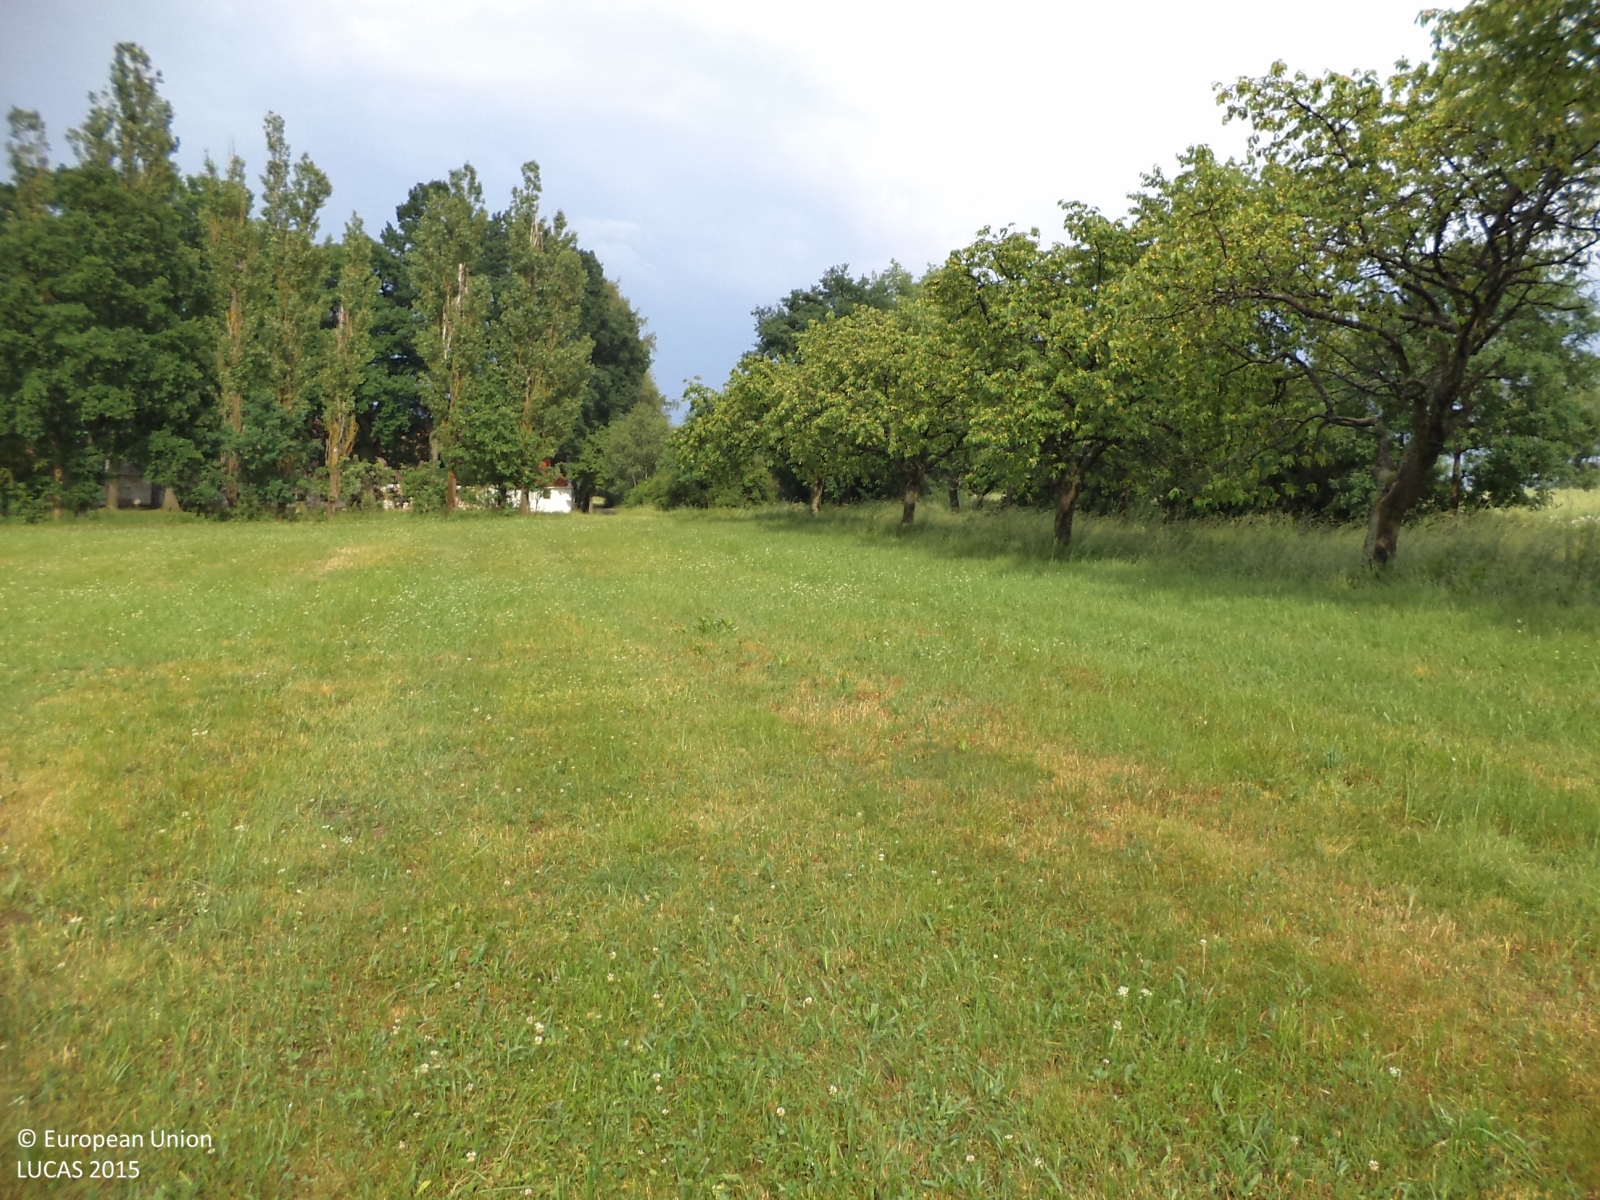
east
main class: Grassland
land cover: Grassland without tree/shrub cover
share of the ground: > 75 %
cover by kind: herbaceous plants 100 %
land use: Agriculture (excluding fallow land and kitchen gardens)
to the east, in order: Grassland without tree/shrub cover; Lines of trees; Paved roads, cycling and walking lanes; Shrubland with sparse tree cover; Paved roads, cycling and walking lanes; Shrubland with sparse tree cover; Rape and turnip rape; Grassland without tree/shrub cover; Artificial constructions in urban areas; Grassland without tree/shrub cover; Rape and turnip rape
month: June
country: CZ
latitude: 49.4096
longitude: 14.5359
